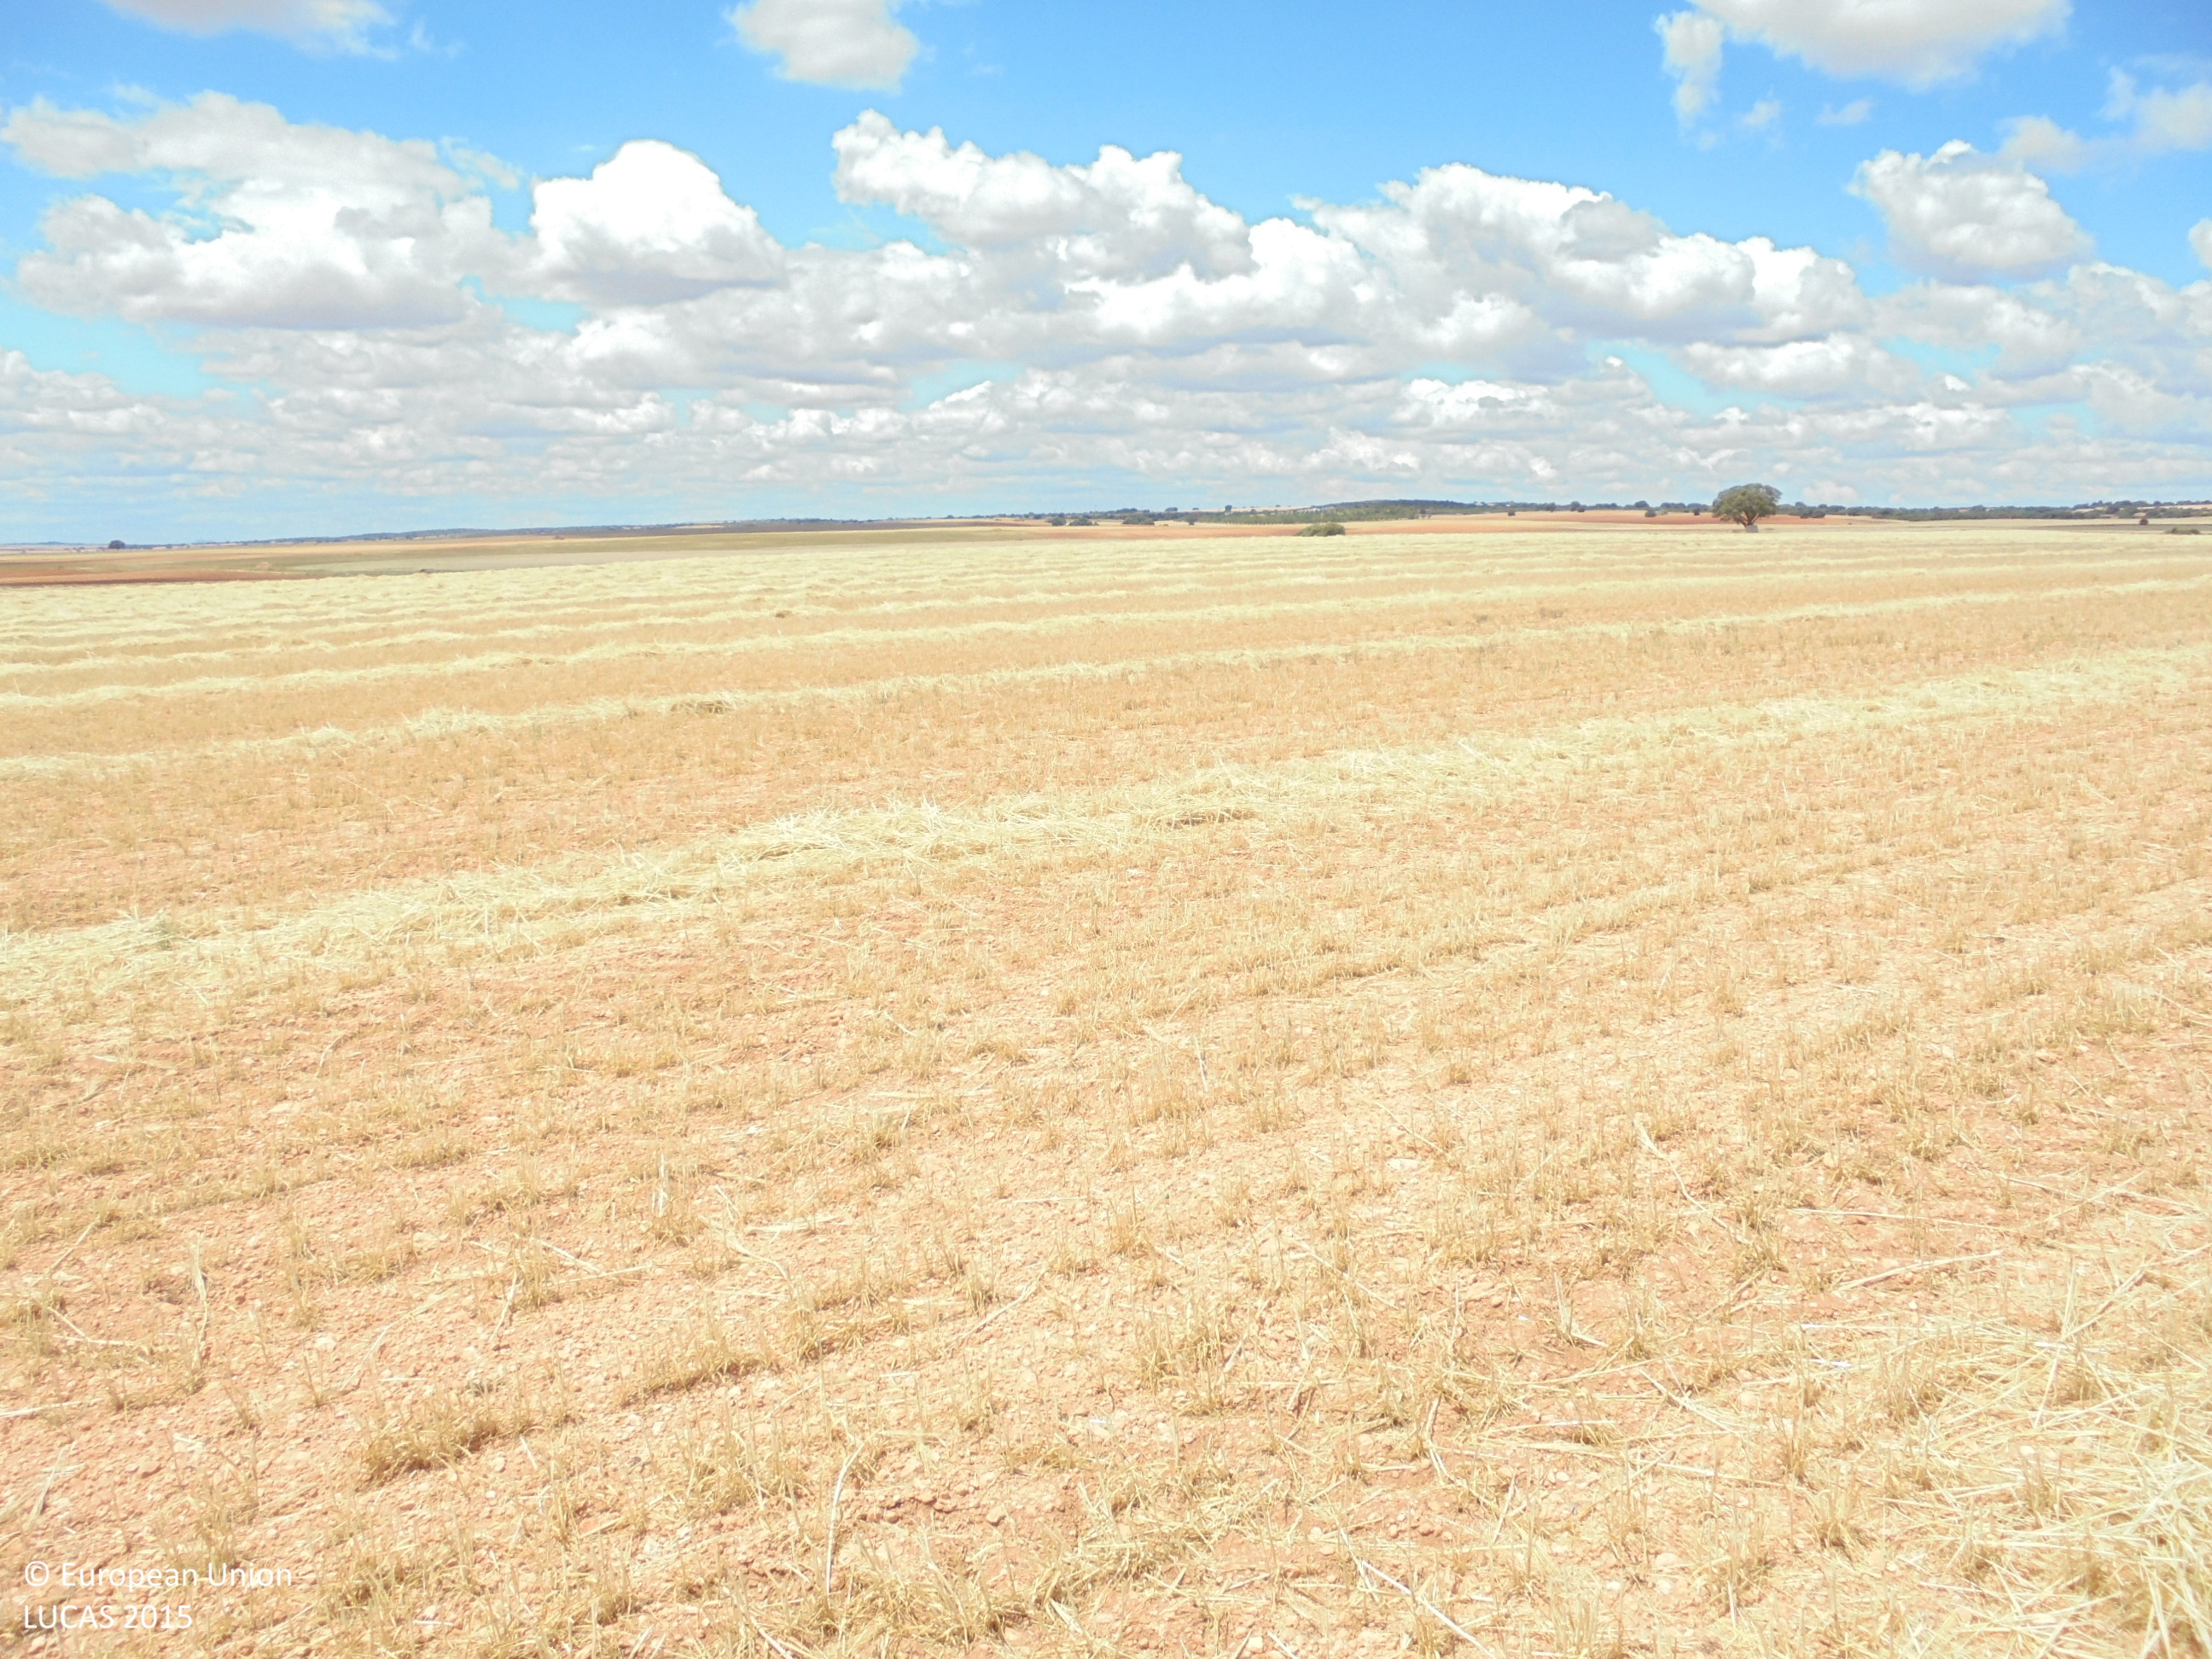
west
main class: Cropland
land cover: Barley
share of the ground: 50 - 75 %
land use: Agriculture (excluding fallow land and kitchen gardens)
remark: Harvested field
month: June
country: ES
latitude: 38.8652
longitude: -1.4403
